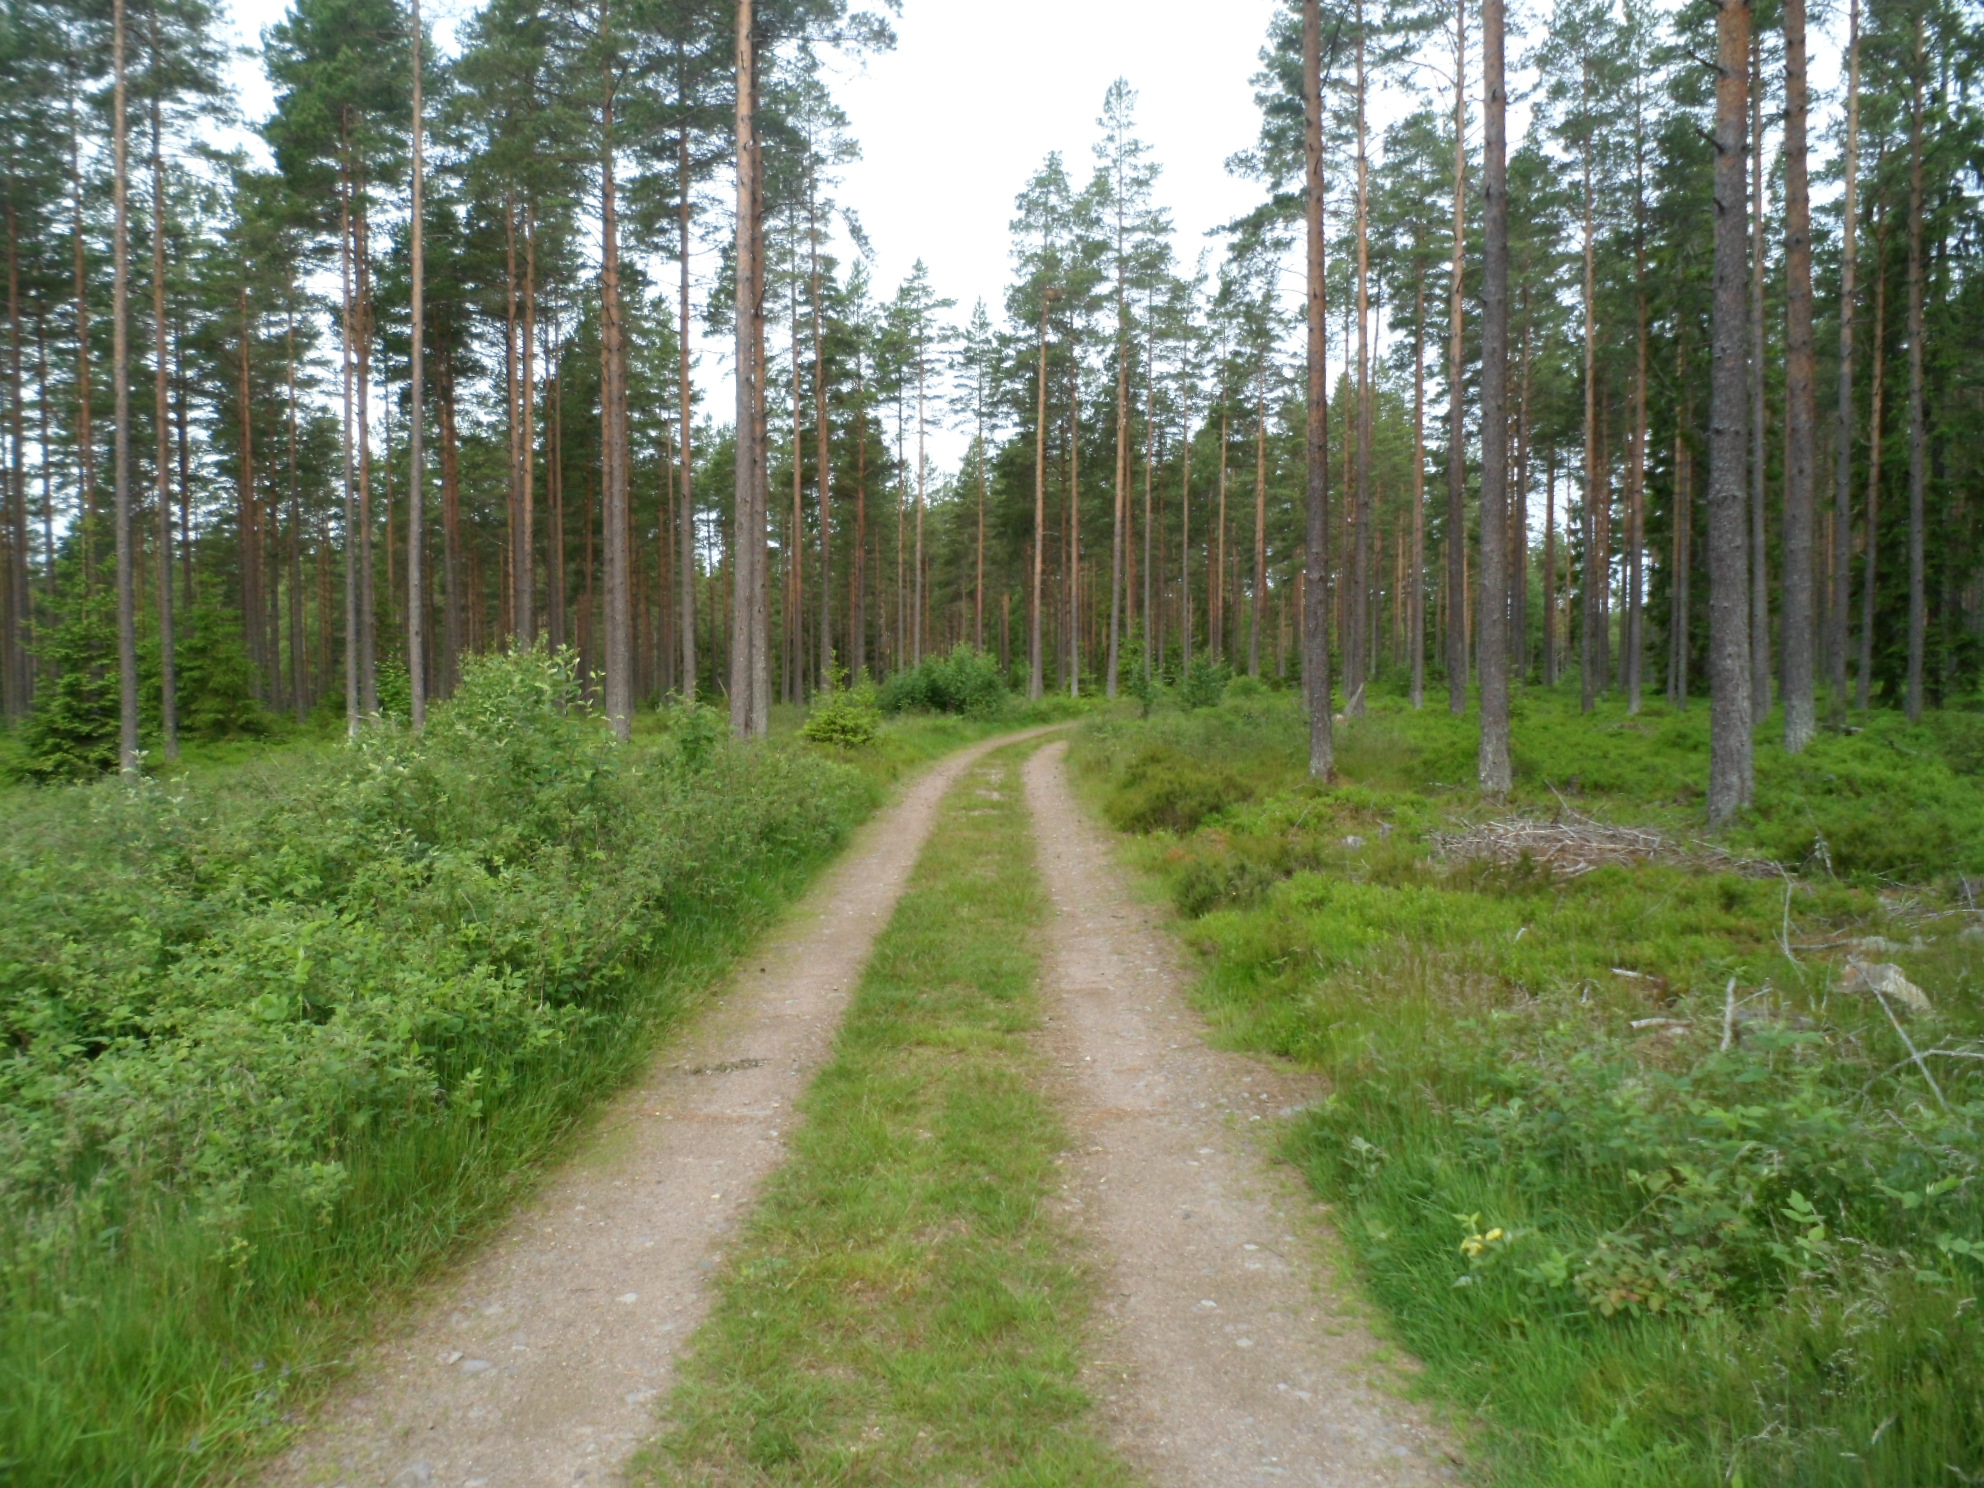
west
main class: Woodland
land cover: Pine dominated coniferous woodland
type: boreal forest
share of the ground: 25 - 50 %
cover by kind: coniferous forest trees 50 %, shrubs 35 %, herbaceous plants 10 %, lichens and mosses 5 %
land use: Forestry
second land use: Amenities, museums, leisure
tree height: > 5 m
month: June
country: SE
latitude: 56.9995
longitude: 15.2490
